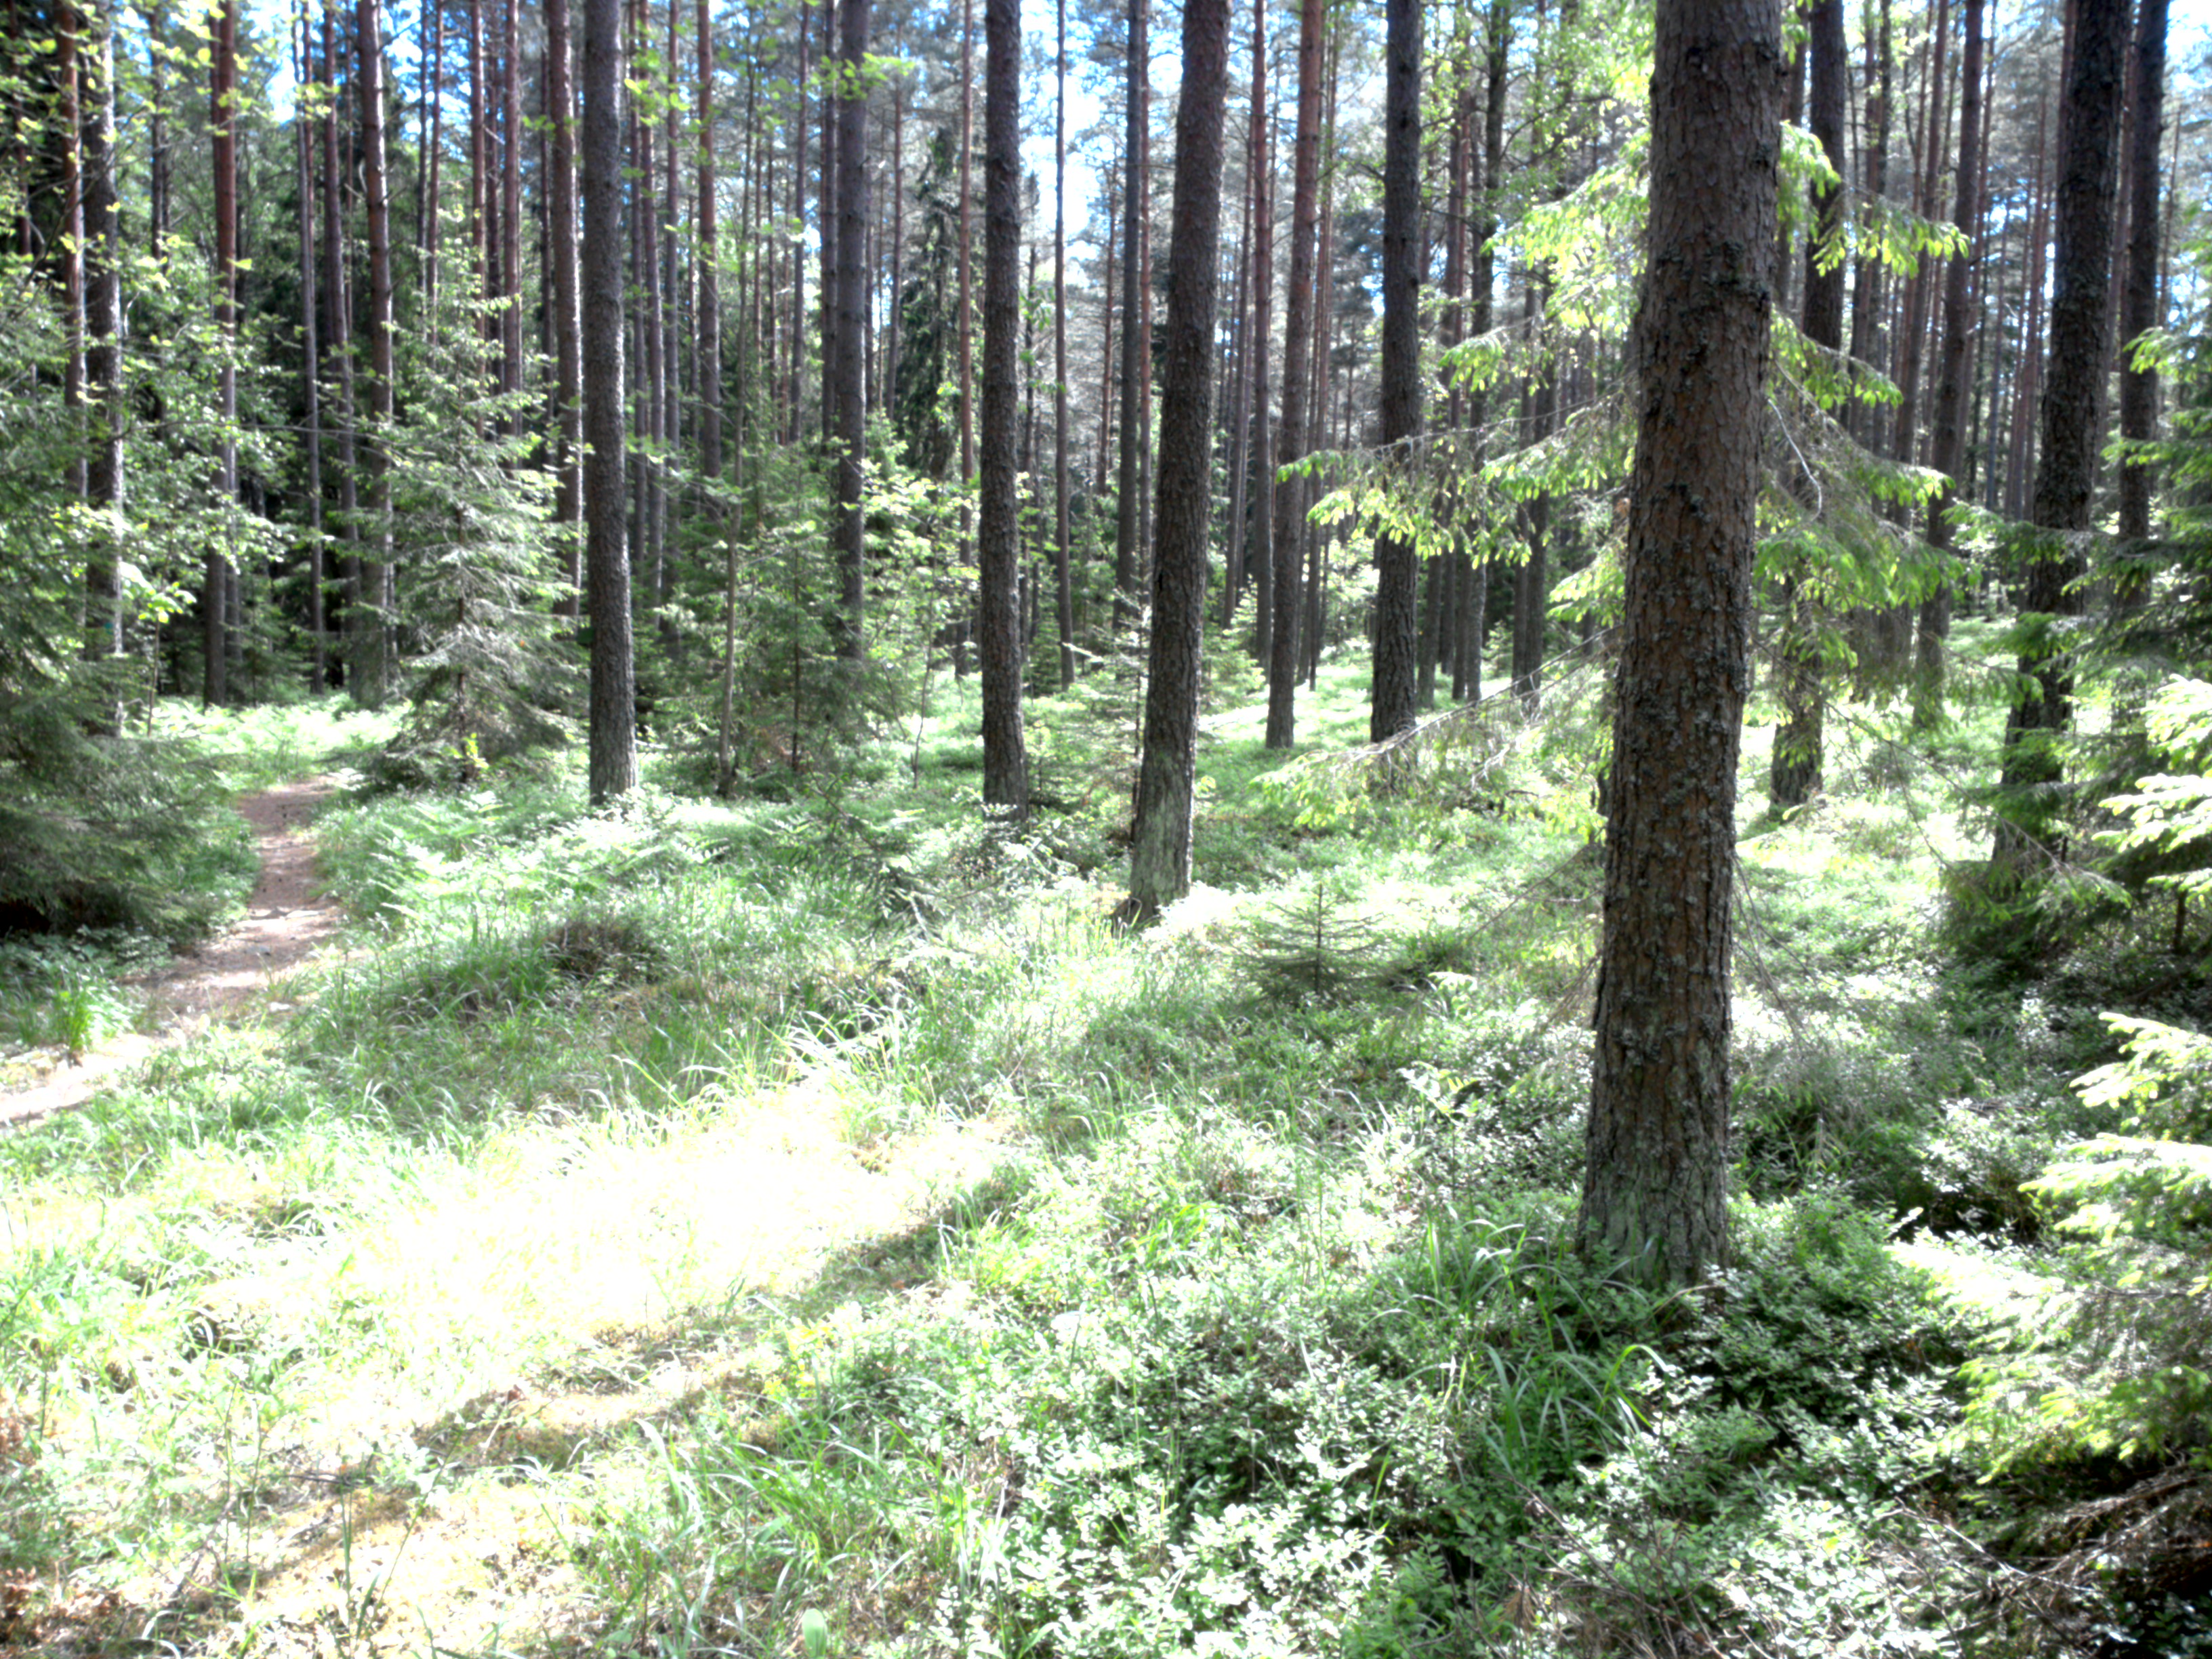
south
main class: Woodland
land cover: Pine dominated coniferous woodland
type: boreal forest
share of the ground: > 75 %
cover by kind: coniferous forest trees 80 %, shrubs 10 %, lichens and mosses 10 %
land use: Forestry
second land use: Sport
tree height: > 5 m
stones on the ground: 10 - 25 %
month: June
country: SE
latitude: 59.4930
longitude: 17.8204
